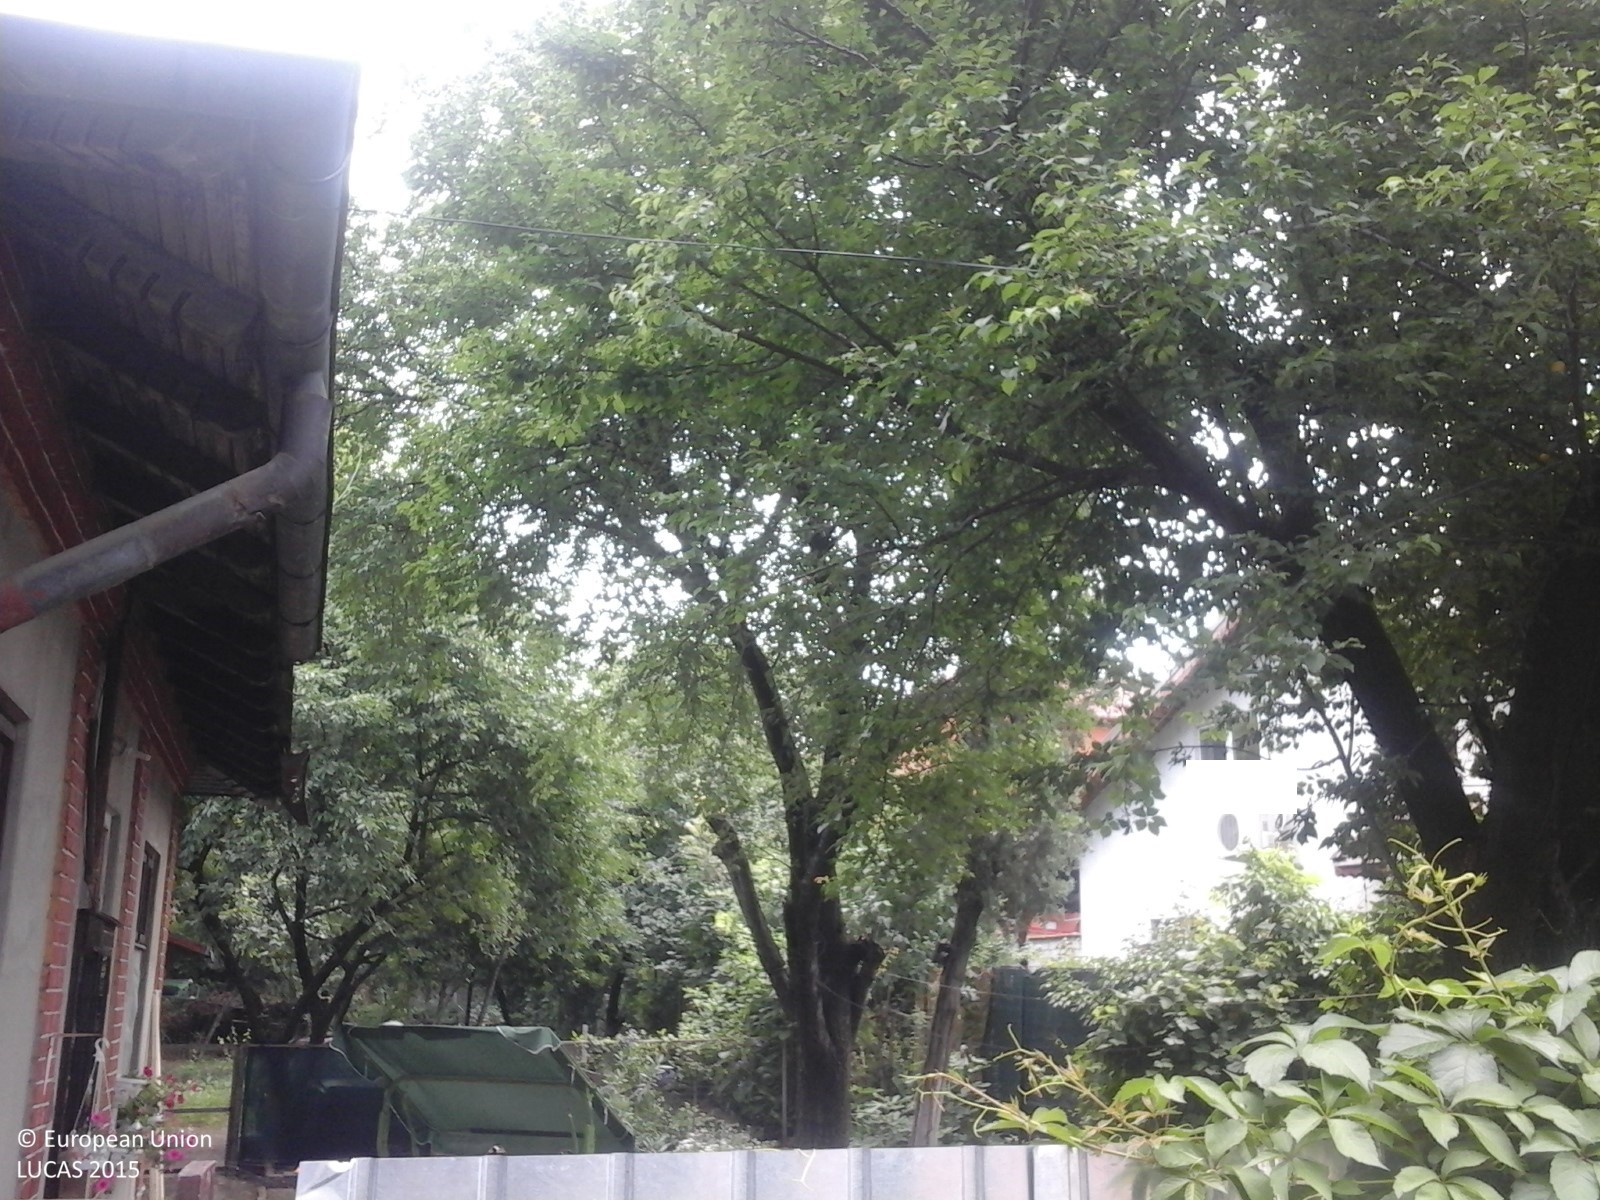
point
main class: Woodland
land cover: Broadleaved woodland
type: mesophytic deciduous forest
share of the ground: > 75 %
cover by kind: broadleaved forest trees 100 %
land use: Residential
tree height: > 5 m
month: June
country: RO
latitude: 44.4071
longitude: 26.0897
